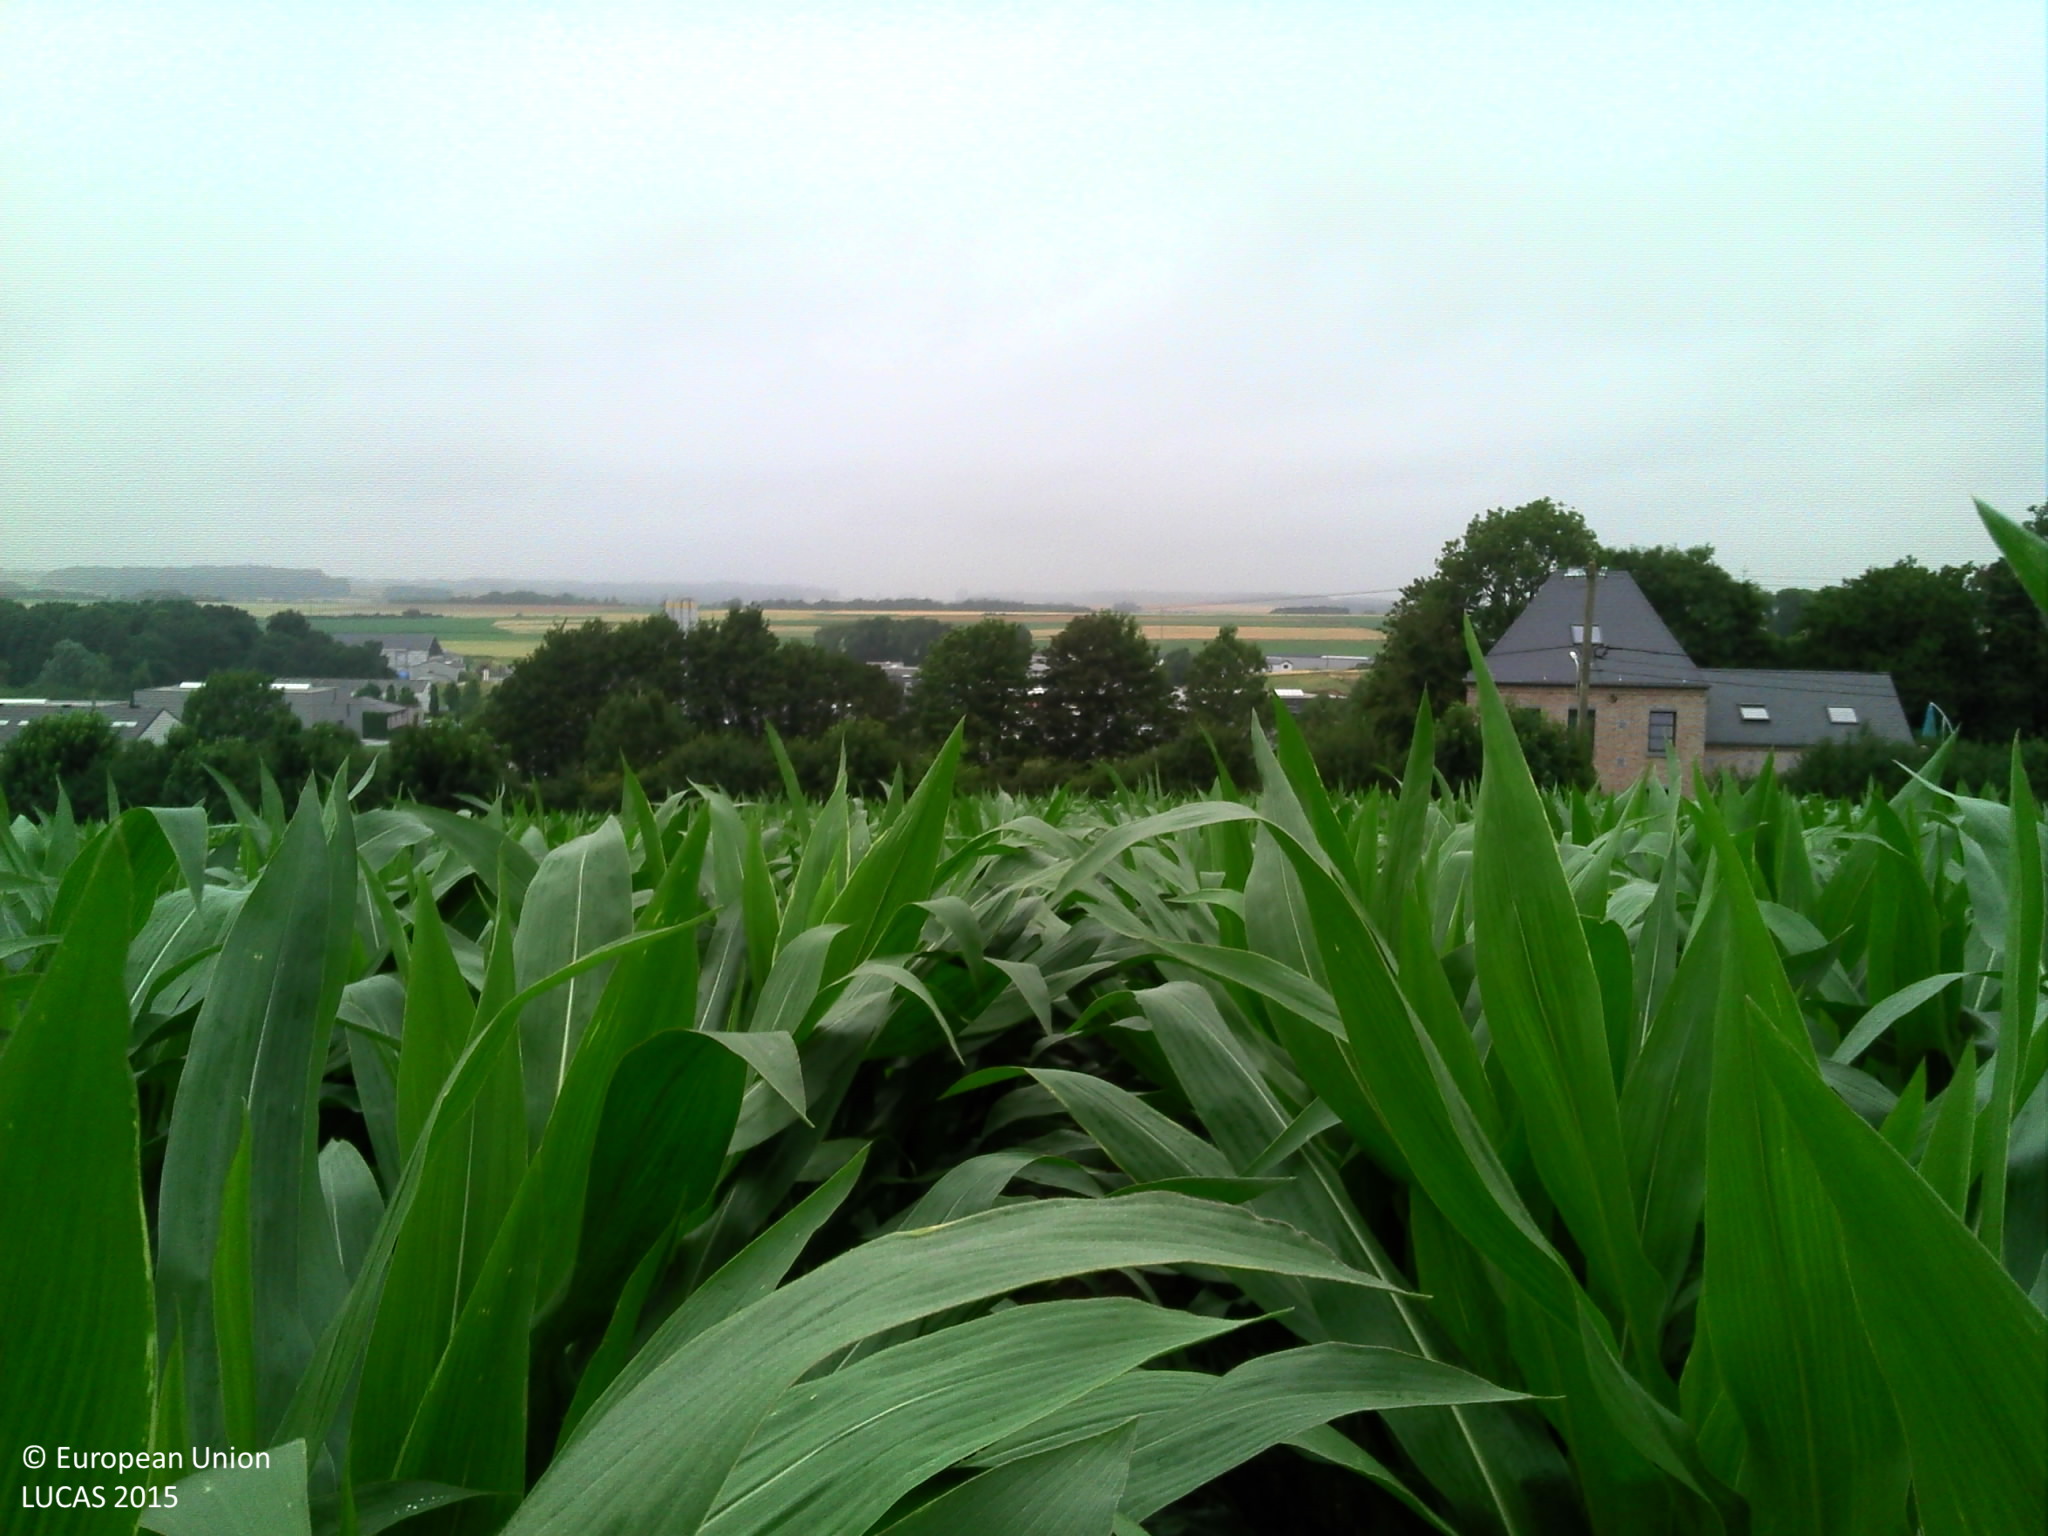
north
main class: Cropland
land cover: Maize
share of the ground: > 75 %
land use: Agriculture (excluding fallow land and kitchen gardens)
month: July
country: BE
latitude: 50.2656
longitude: 4.4544
